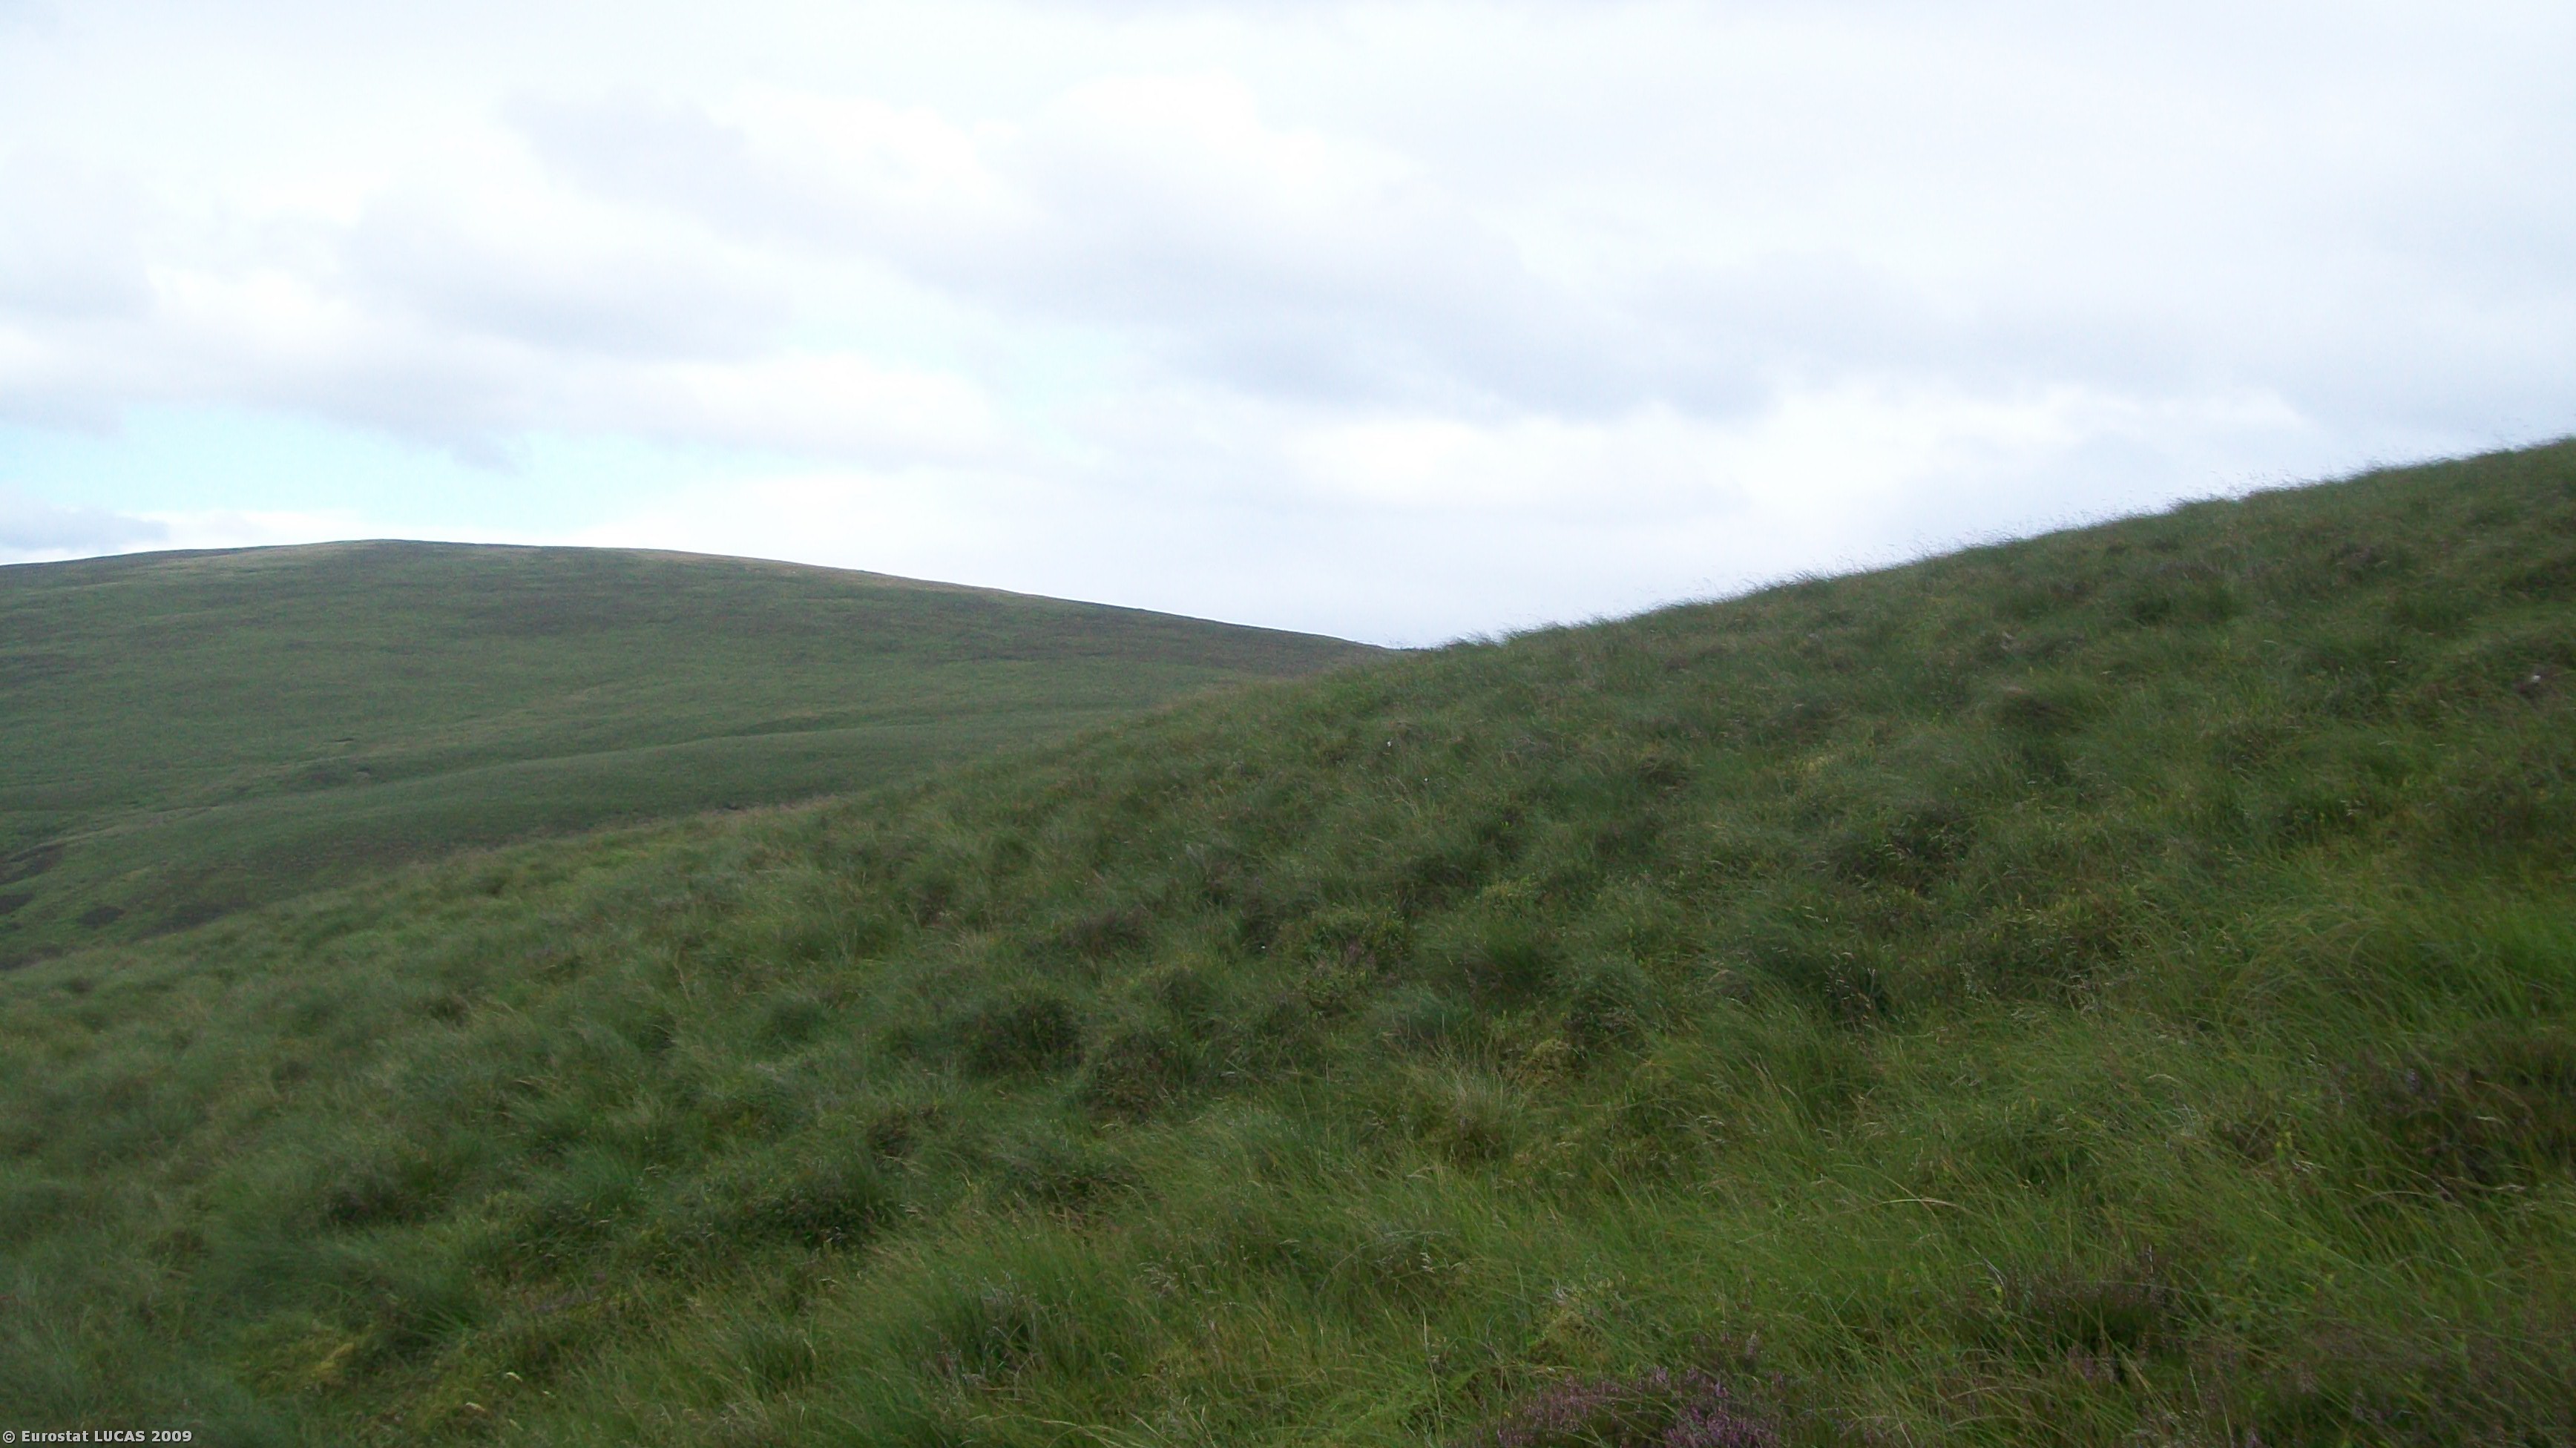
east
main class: Shrubland
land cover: Shrubland without tree cover
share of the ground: > 75 %
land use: Agriculture (excluding fallow land and kitchen gardens)
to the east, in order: Shrubland without tree cover; Grassland without tree/shrub cover
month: August
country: GB
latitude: 55.5109
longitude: -3.4588
